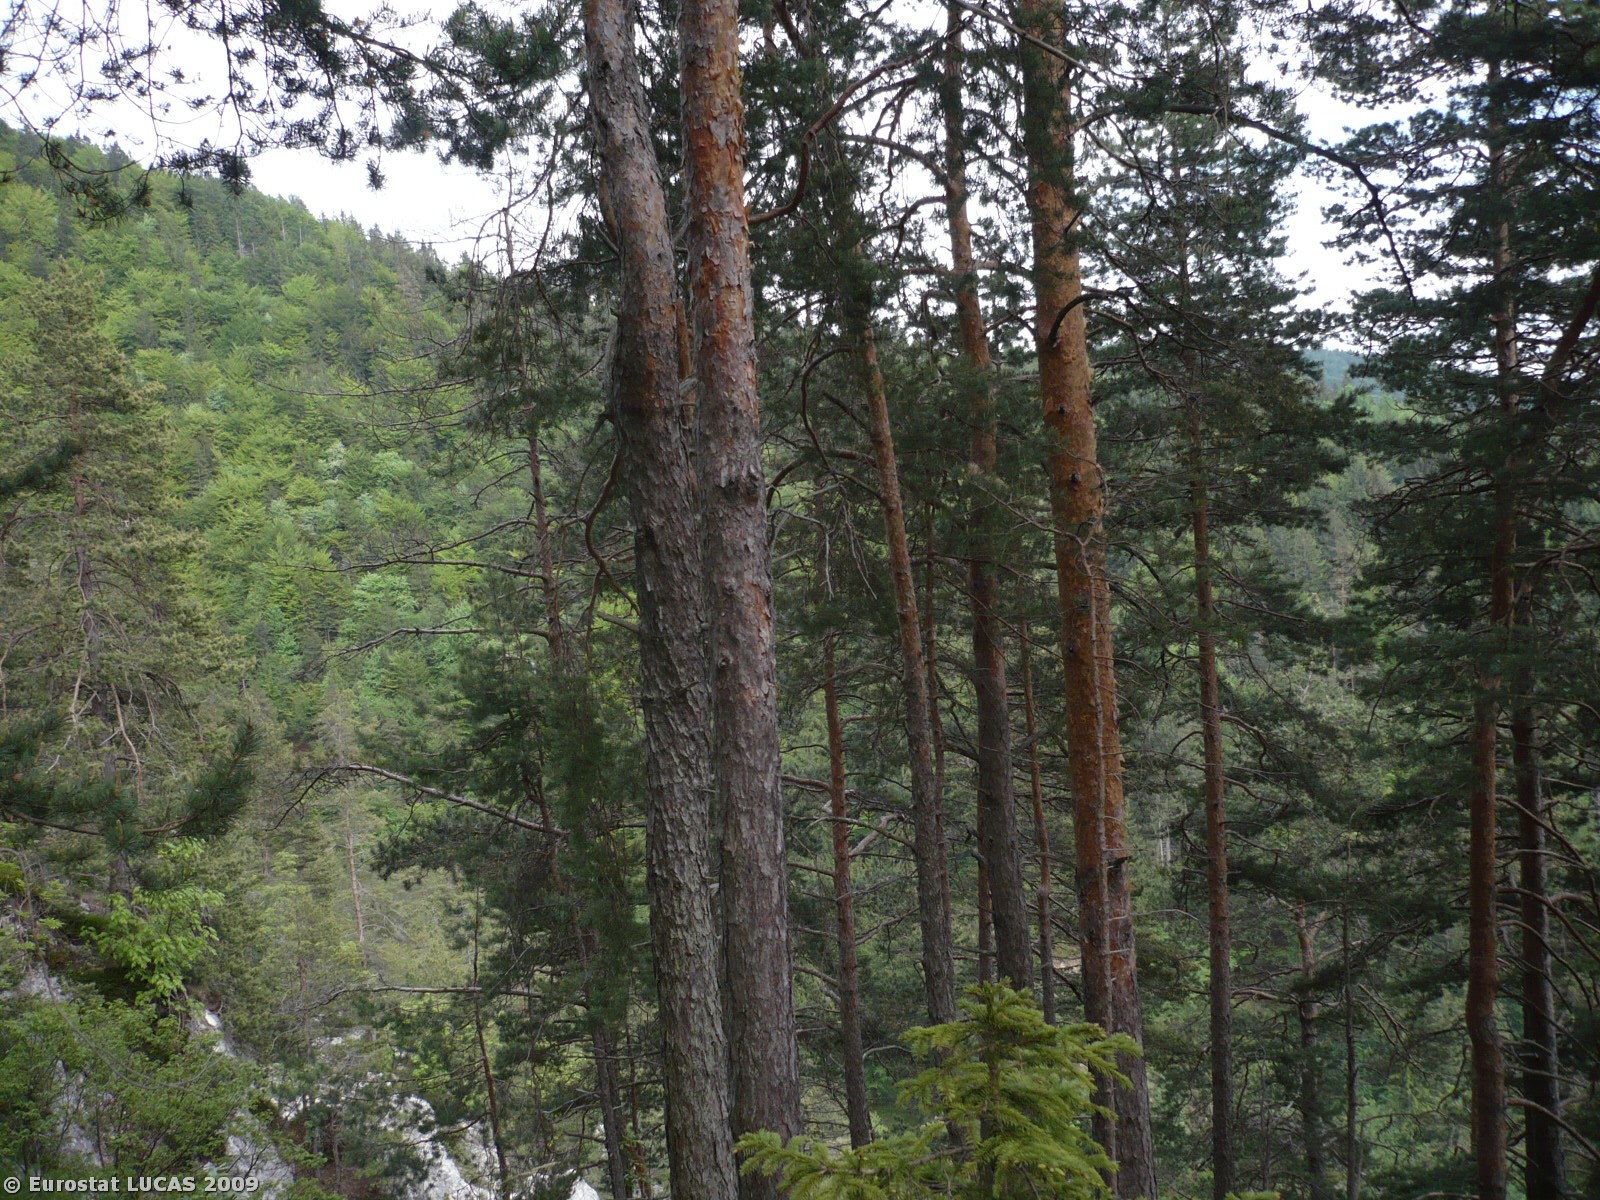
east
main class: Woodland
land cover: Coniferous woodland
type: alpine coniferous forest
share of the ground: 50 - 75 %
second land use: Nature reserves
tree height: > 5 m
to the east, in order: Coniferous woodland; Ditches and canals; Bare land; Ditches and canals; Bare land; Coniferous woodland; Ditches and canals; Coniferous woodland; Grassland with sparse tree/shrub cover; Ditches and canals; Mixed woodland
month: May
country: SI
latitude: 46.3339
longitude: 14.3749
